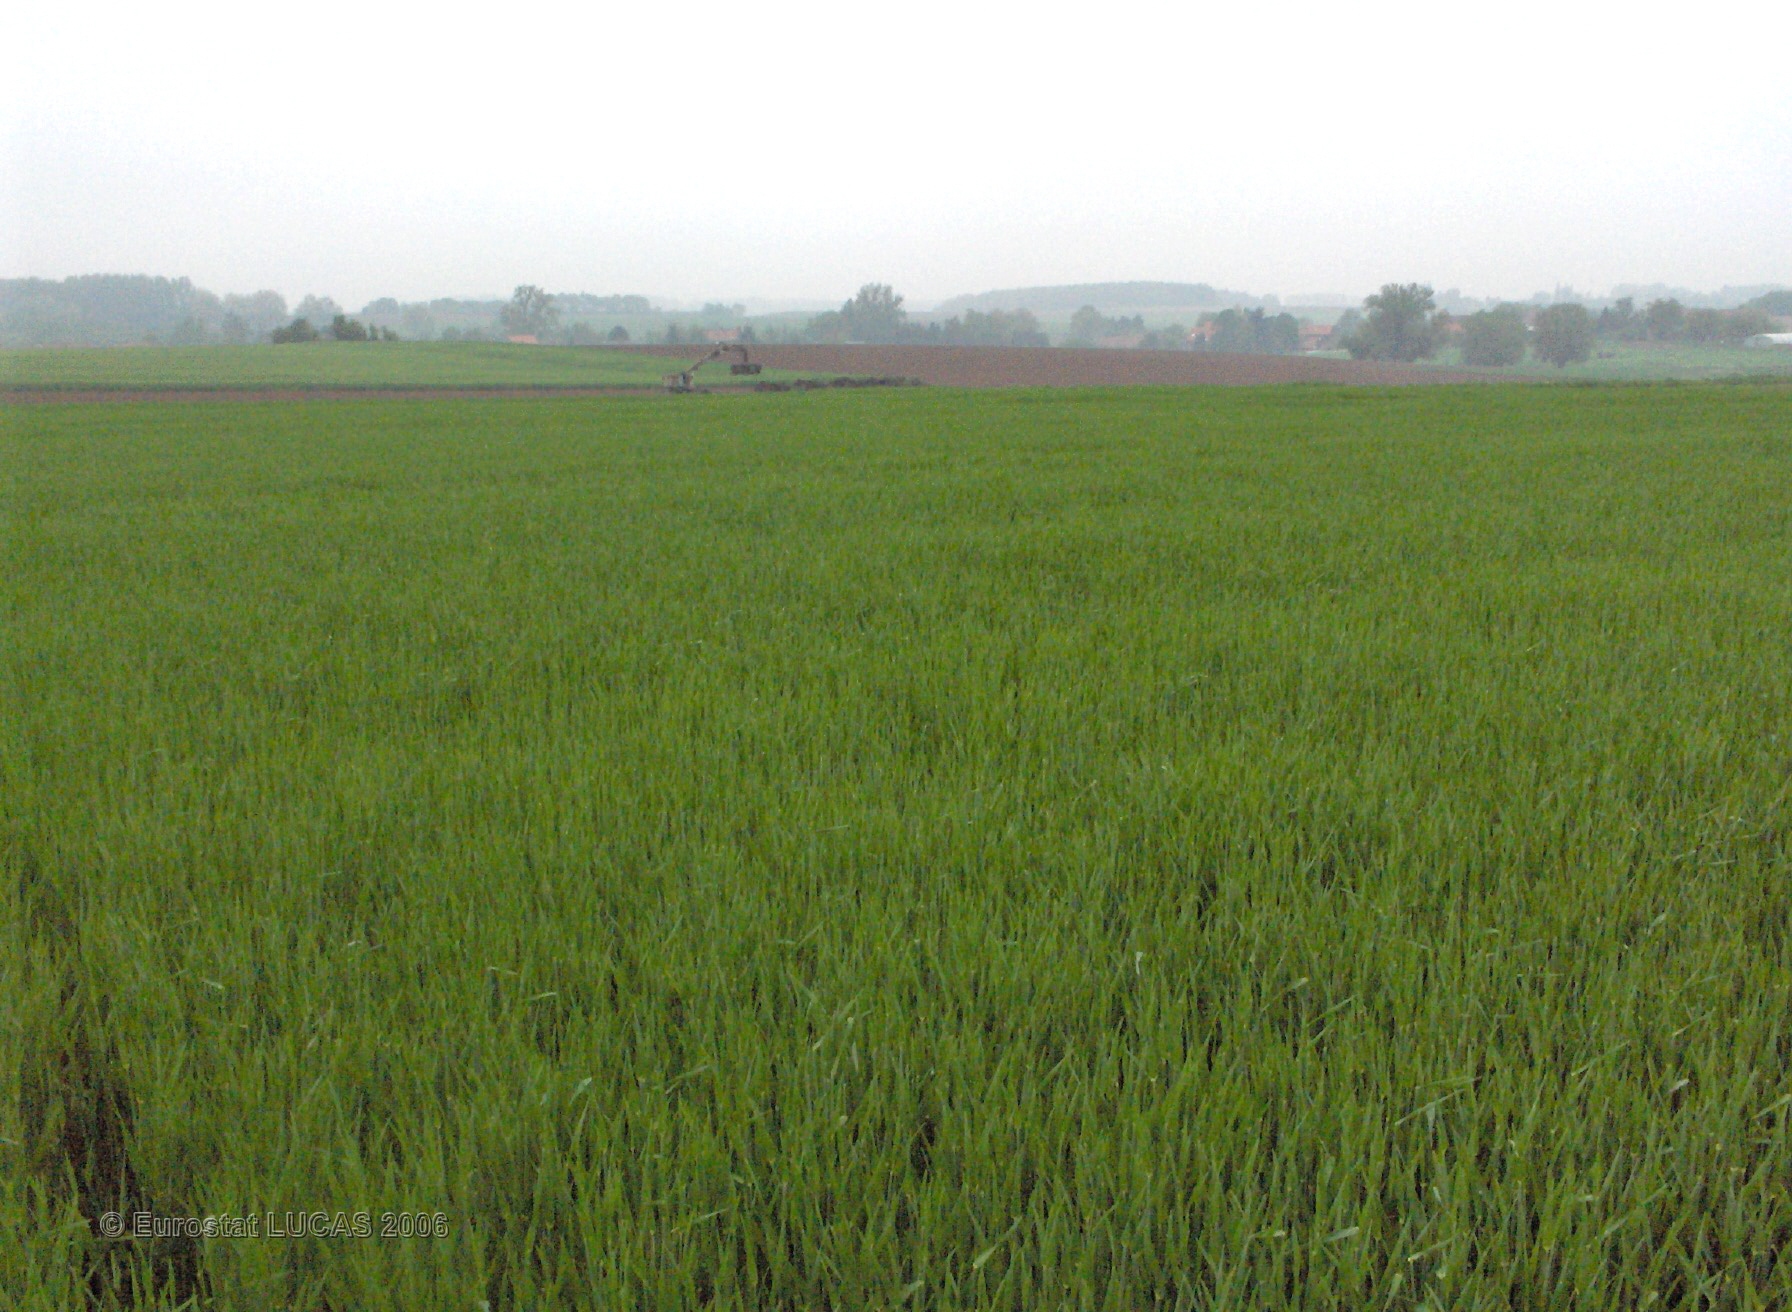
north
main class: Cropland
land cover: Common wheat
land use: Agriculture (excluding fallow land and kitchen gardens)
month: May
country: BE
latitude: 50.5551
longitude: 4.4769
